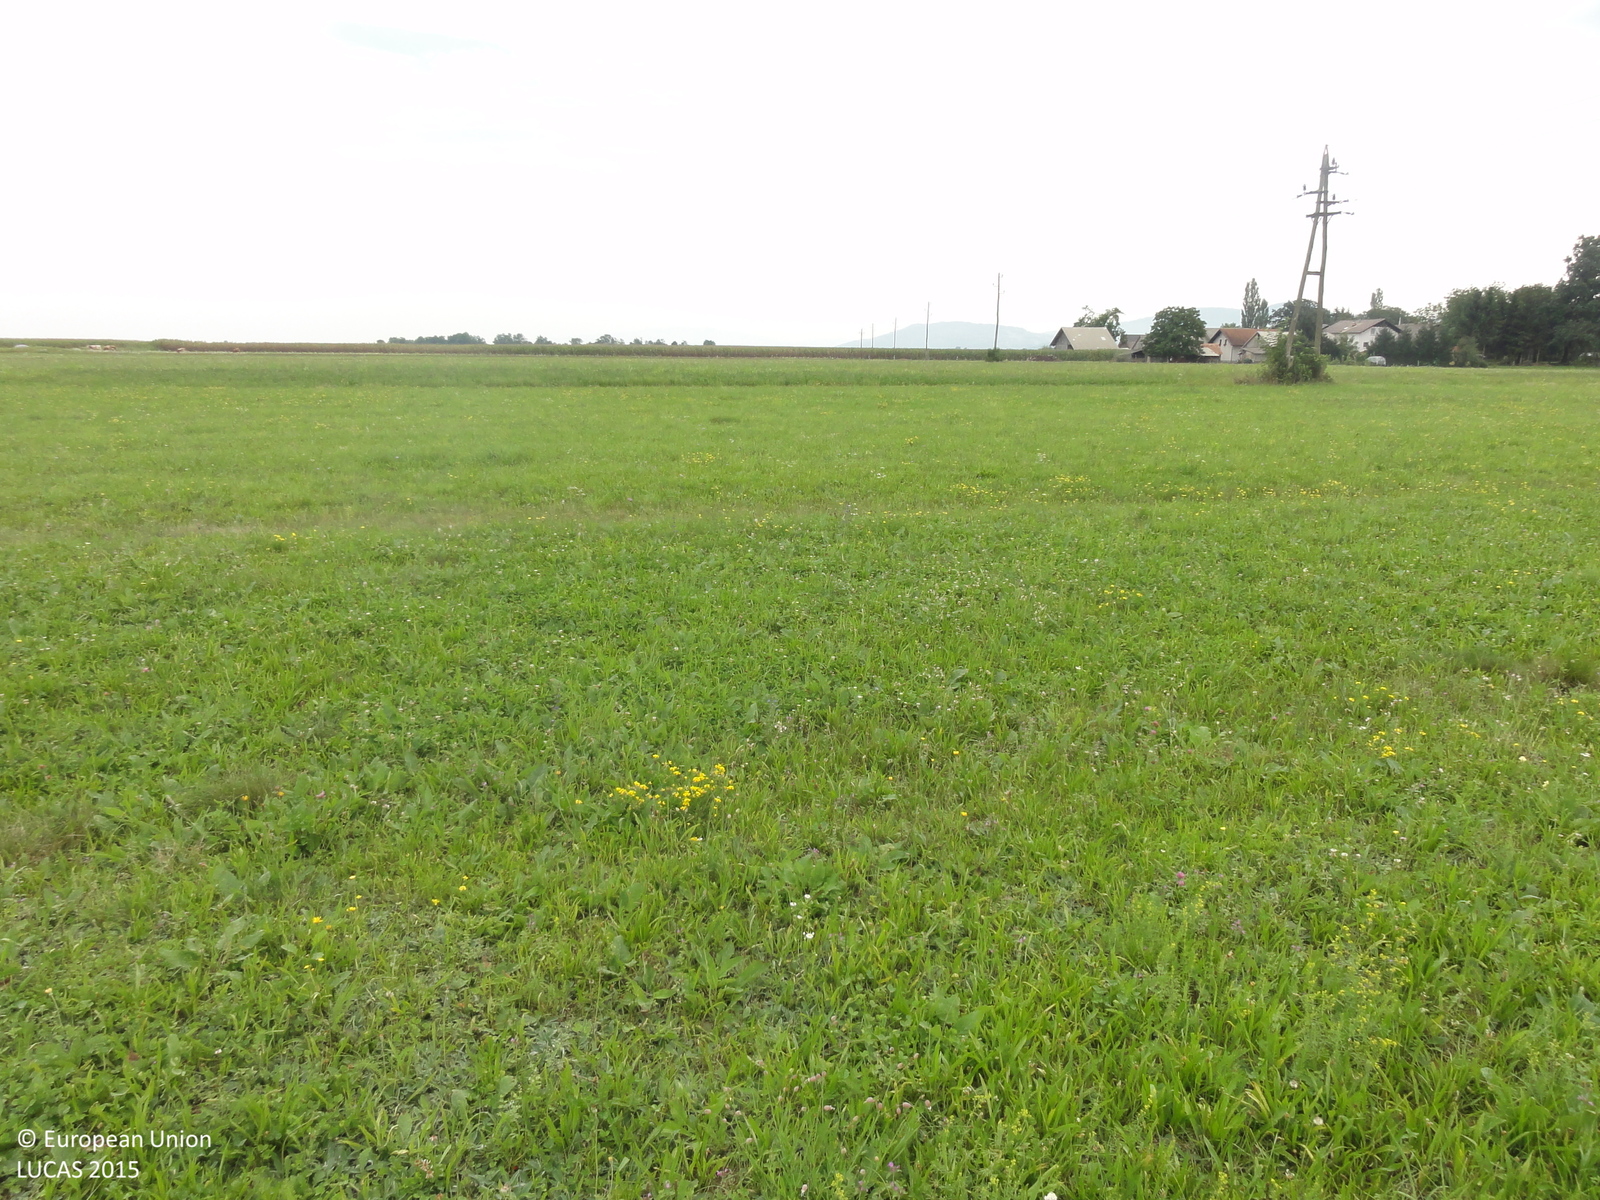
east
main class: Grassland
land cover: Grassland without tree/shrub cover
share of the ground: > 75 %
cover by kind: herbaceous plants 100 %
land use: Agriculture (excluding fallow land and kitchen gardens)
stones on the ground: < 10 %
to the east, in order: Grassland without tree/shrub cover; Clovers; Ditches and canals; Grassland without tree/shrub cover; Other bare soil; Grassland without tree/shrub cover; Fences; Grassland without tree/shrub cover; Fences; Temporary grasslands; Fences; Grassland without tree/shrub cover; Fences; Grassland without tree/shrub cover; Fences; Grassland without tree/shrub cover
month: August
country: SI
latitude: 45.9041
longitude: 15.4755
